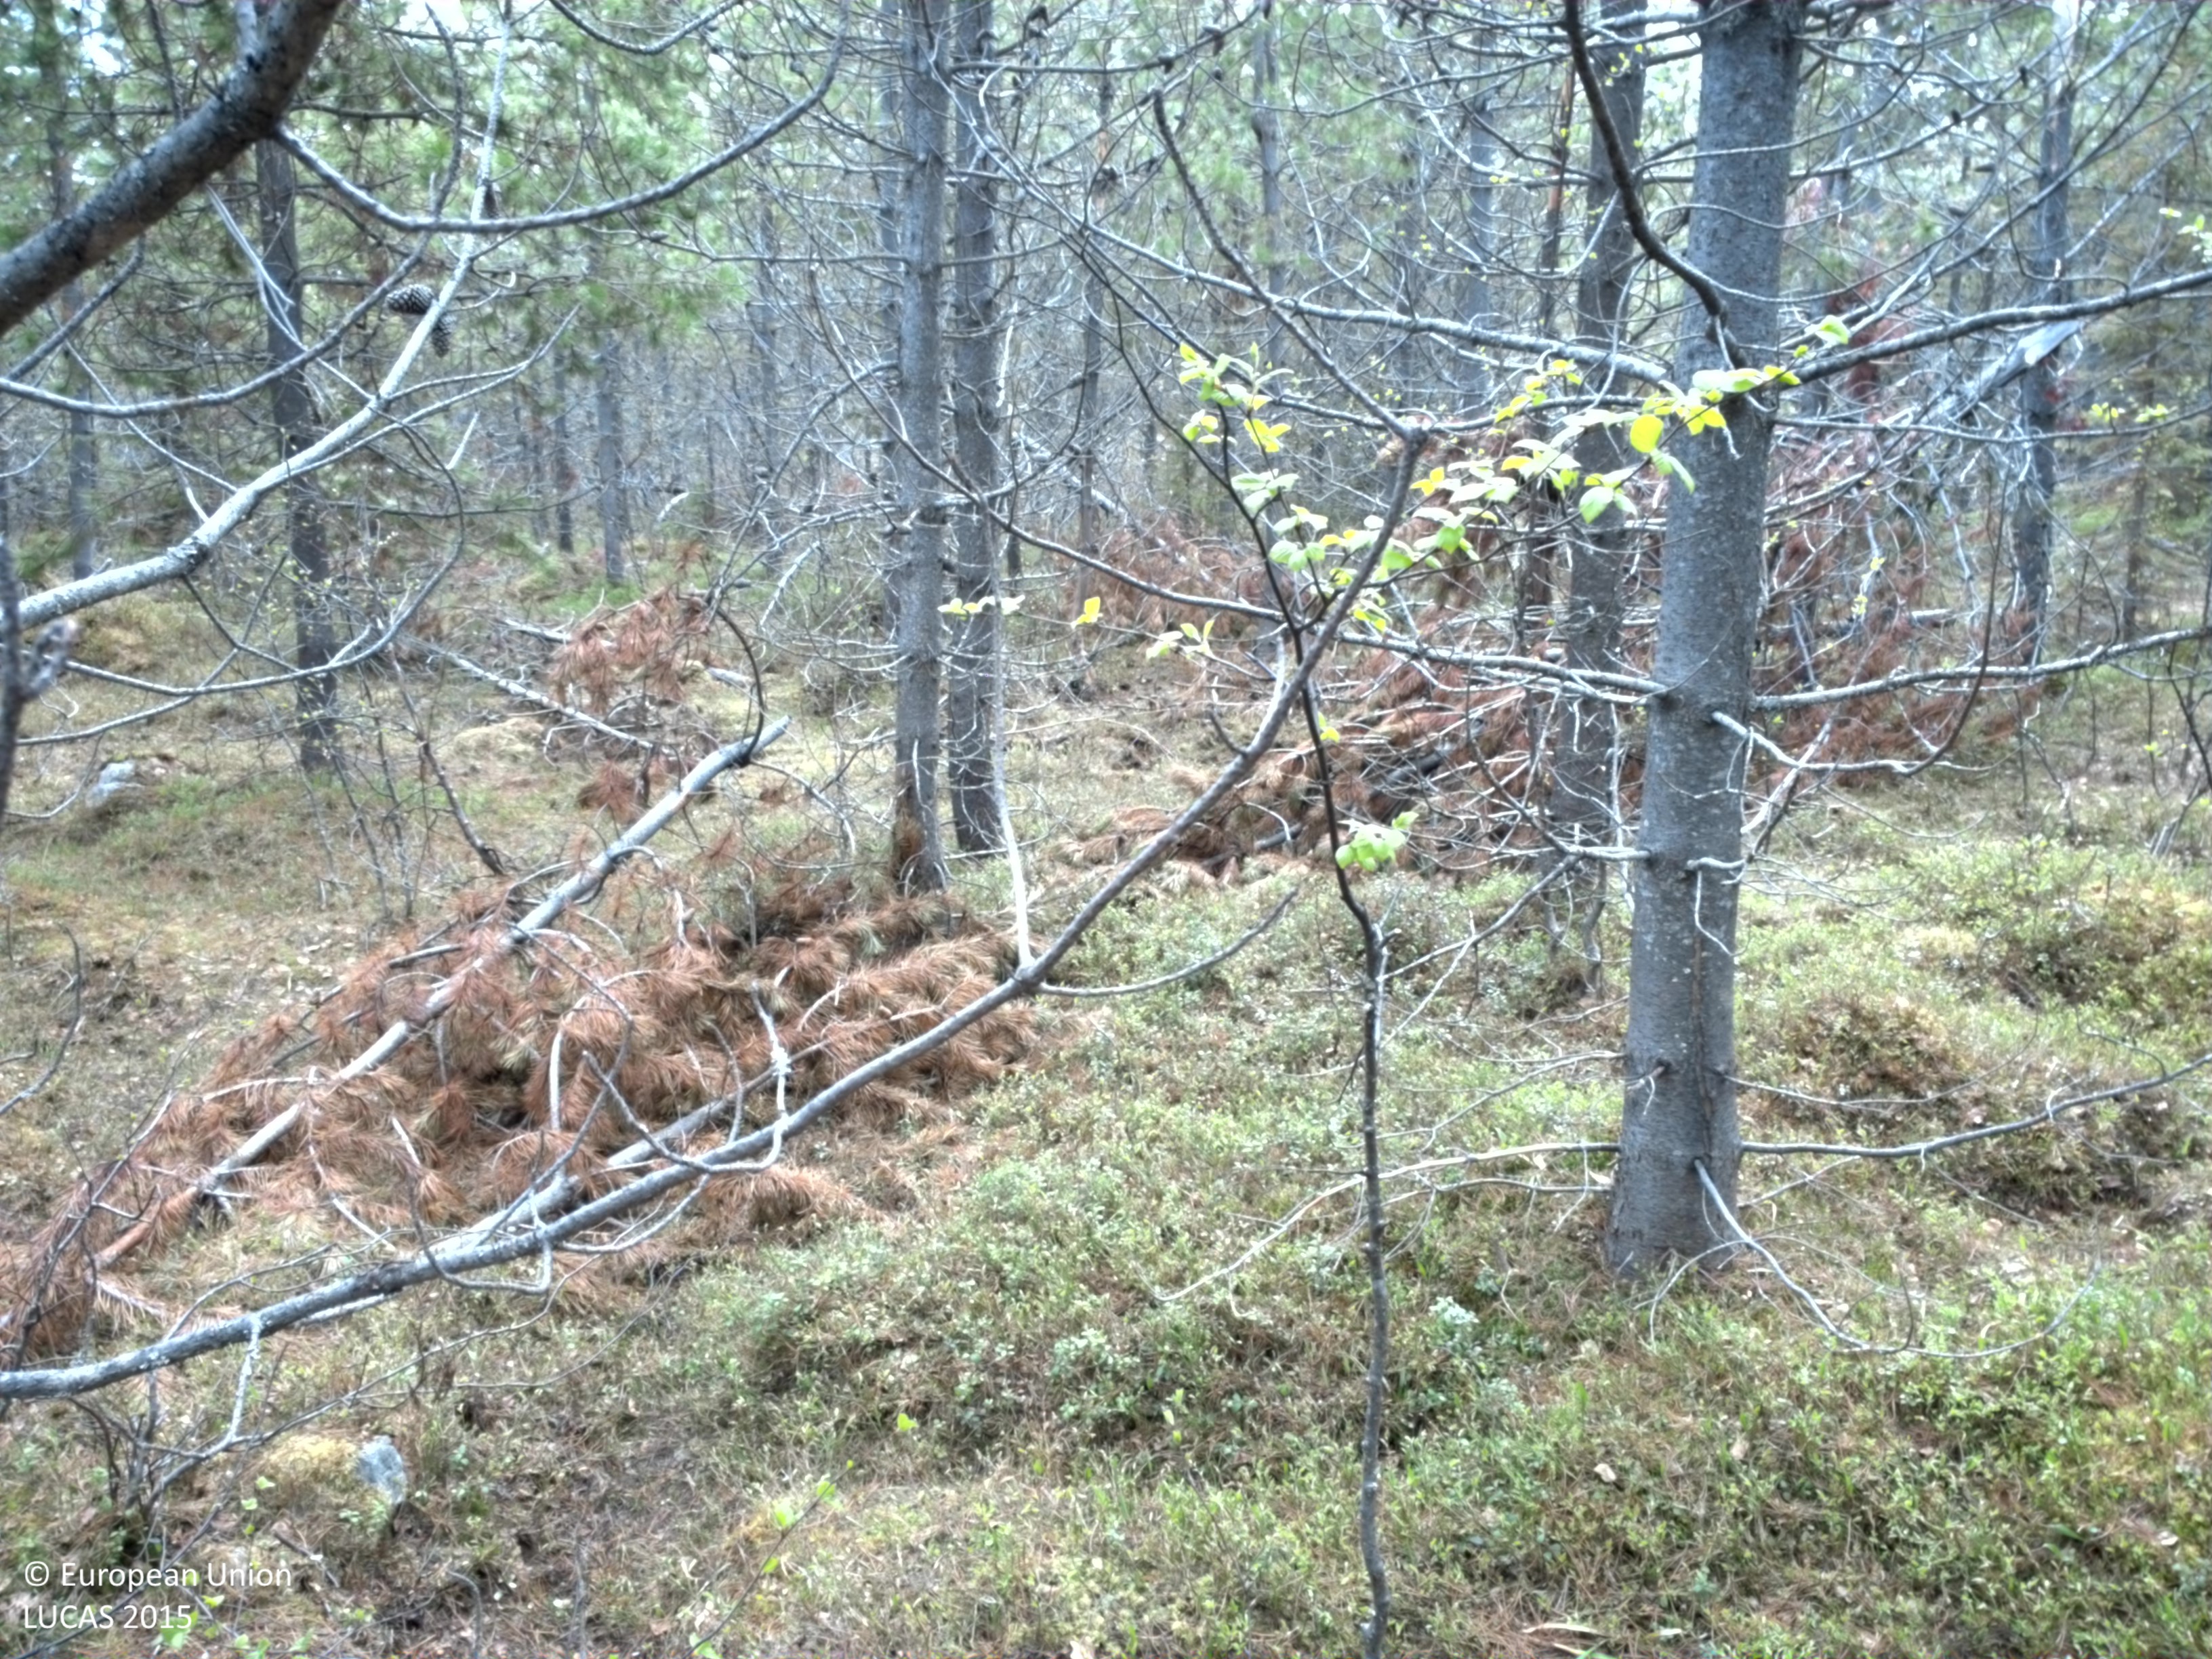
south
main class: Woodland
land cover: Pine dominated coniferous woodland
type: exotic forest
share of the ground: > 75 %
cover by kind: coniferous forest trees 75 %, shrubs 15 %, broadleaved forest trees 5 %, lichens and mosses 5 %
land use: Forestry
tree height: > 5 m
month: June
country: SE
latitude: 66.2667
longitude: 22.2856
